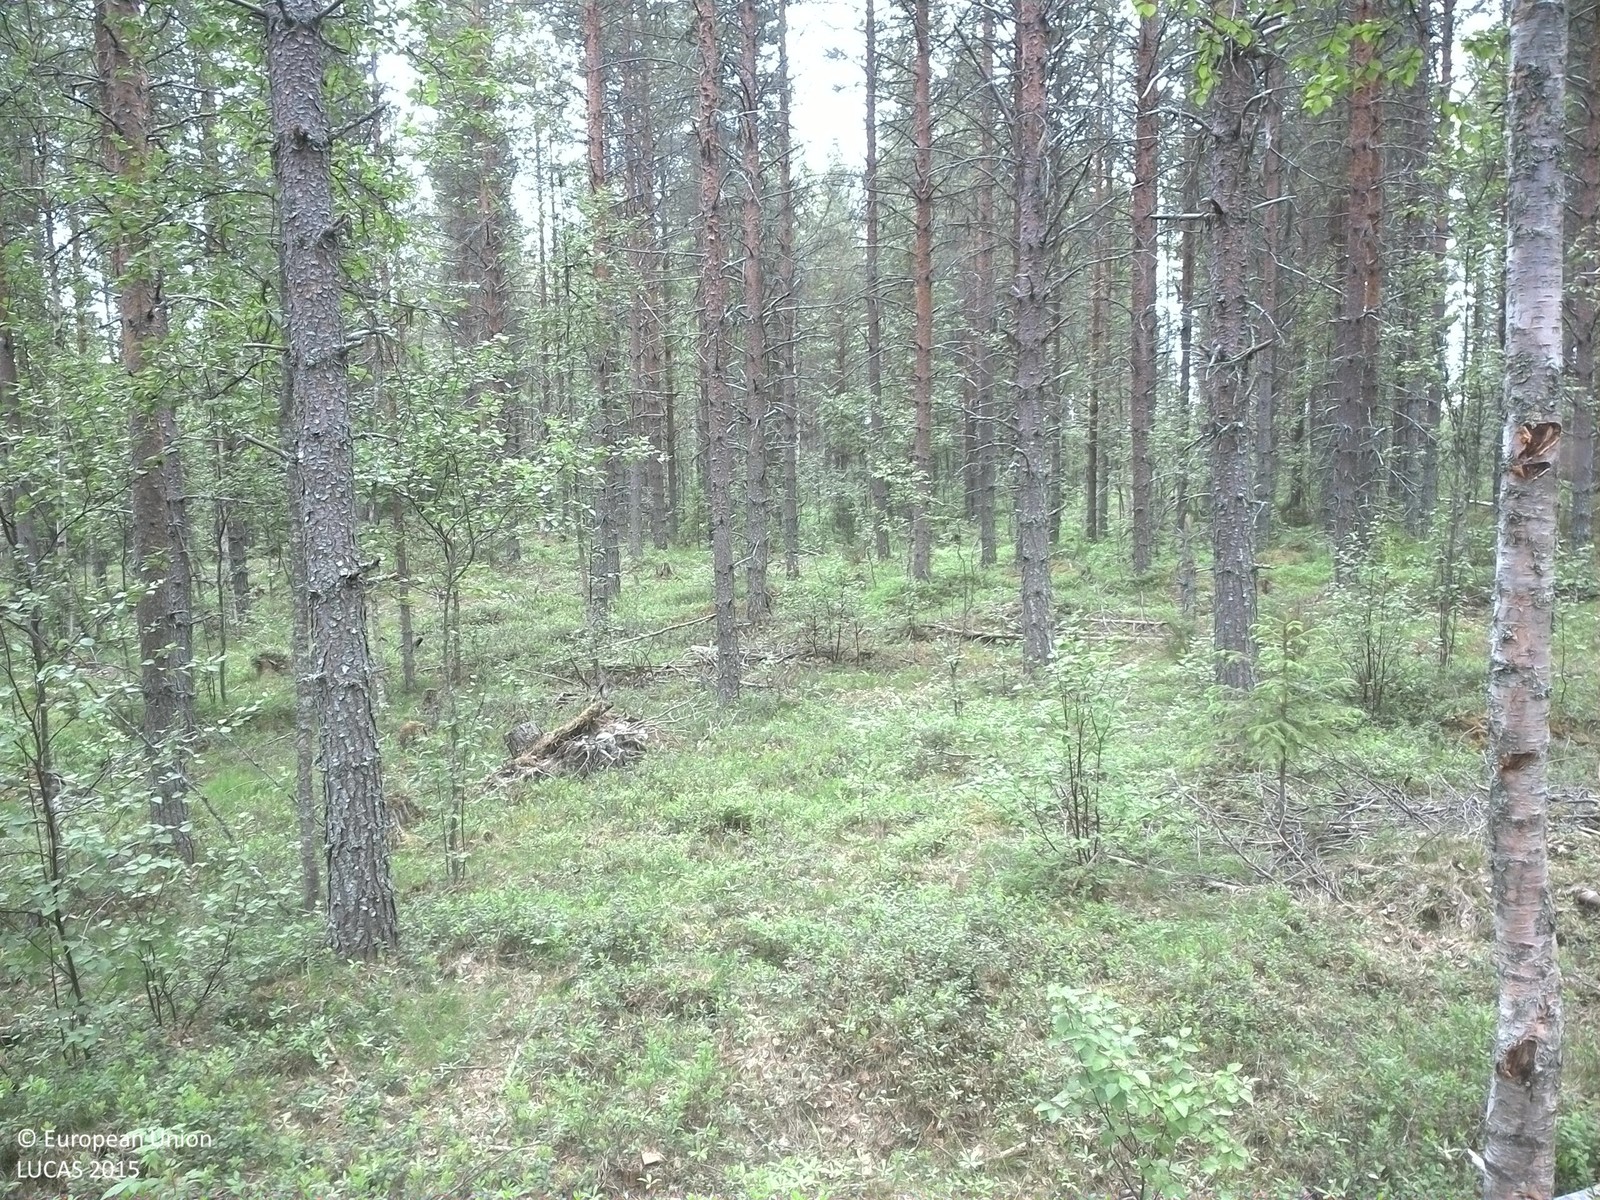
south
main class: Woodland
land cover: Pine dominated coniferous woodland
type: boreal forest
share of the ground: 25 - 50 %
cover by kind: shrubs 35 %, coniferous forest trees 30 %, herbaceous plants 15 %, lichens and mosses 10 %, broadleaved forest trees 5 %, unconsolidated bare surface 5 %
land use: Forestry
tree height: > 5 m
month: July
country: SE
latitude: 64.1610
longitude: 16.8175
